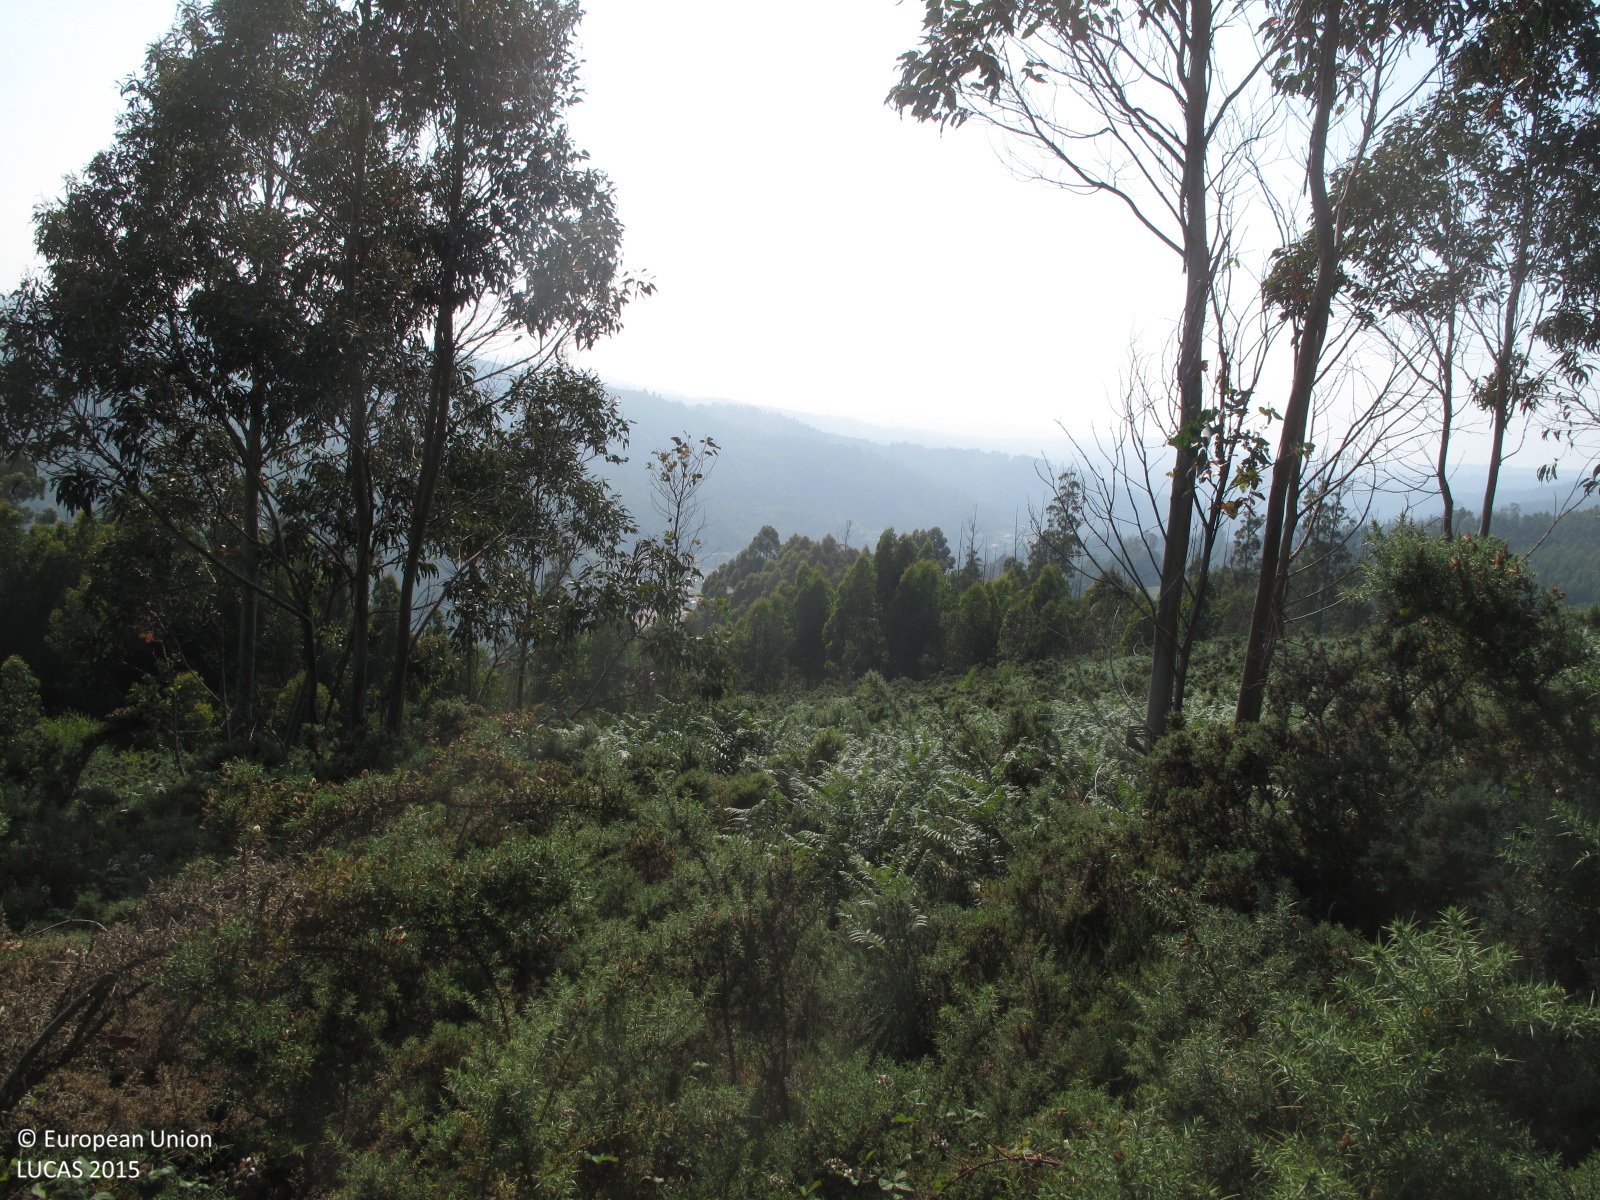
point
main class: Shrubland
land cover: Shrubland without tree cover
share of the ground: > 75 %
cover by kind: shrubs 90 %, herbaceous plants 10 %
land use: Semi-natural and natural areas not in use
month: June
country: ES
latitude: 43.2382
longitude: -8.0106
